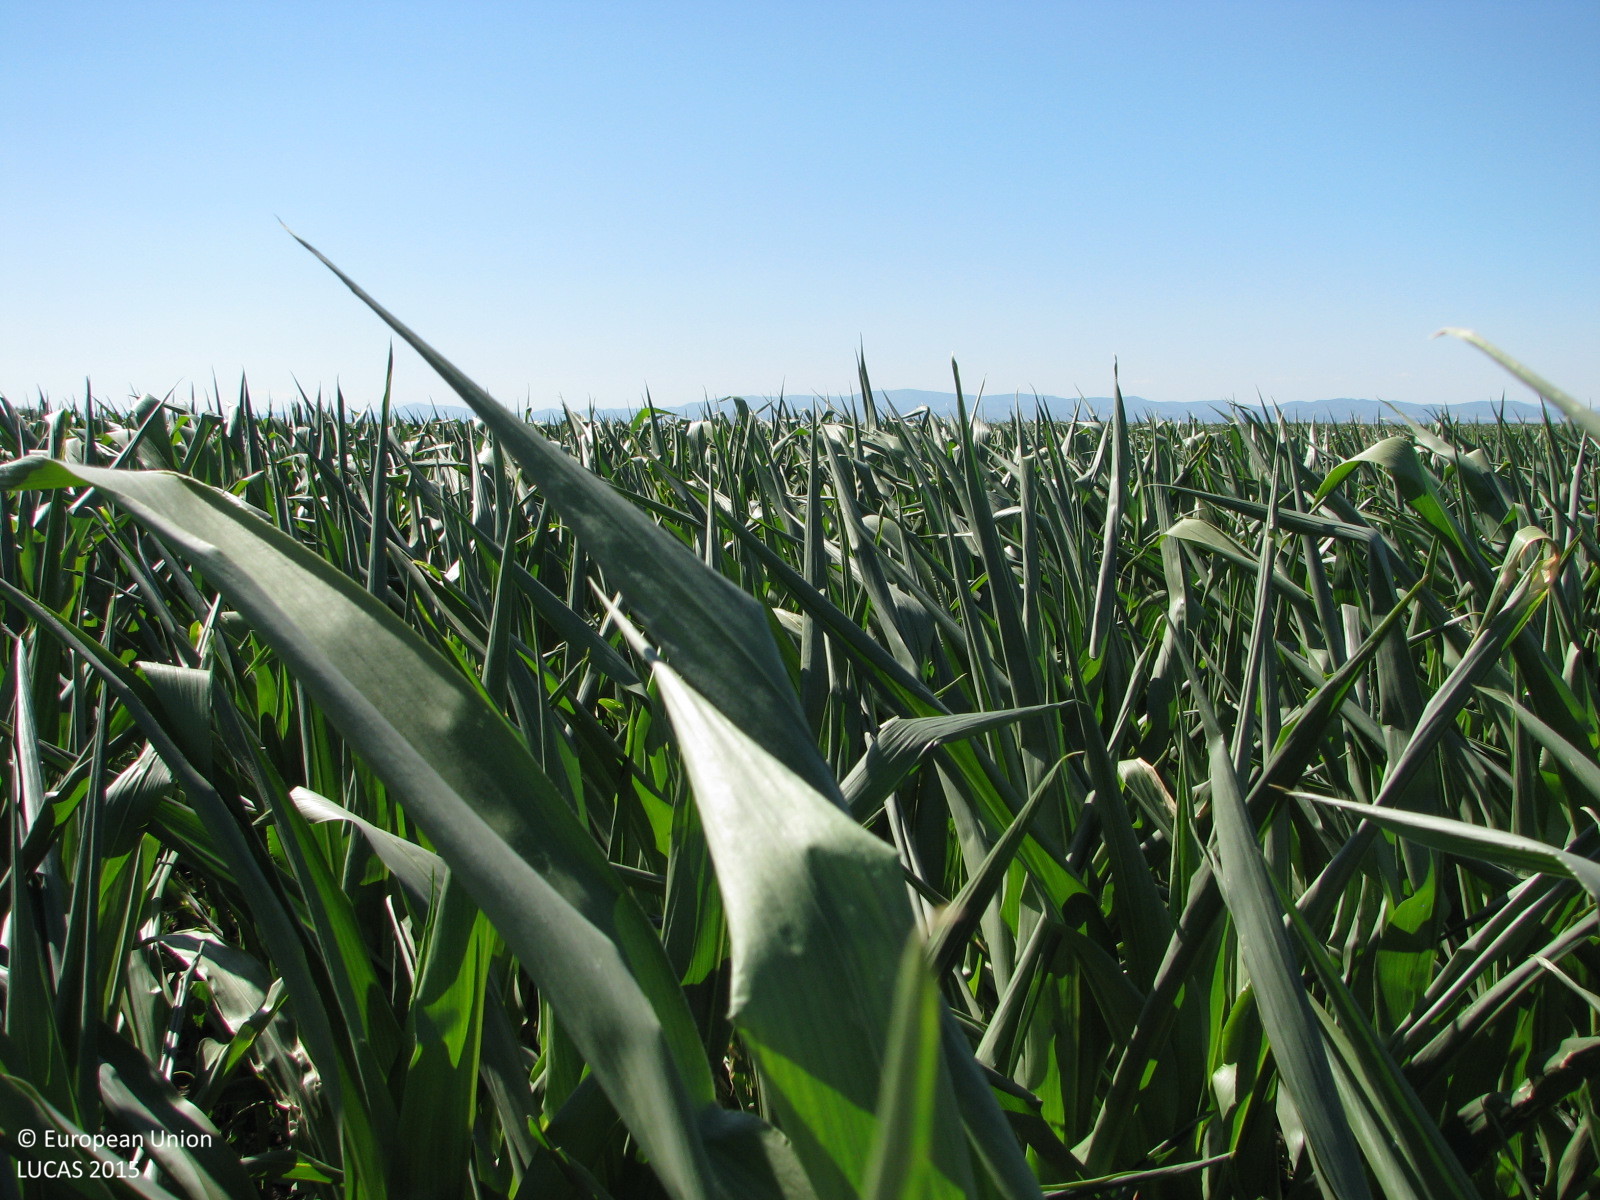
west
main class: Cropland
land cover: Maize
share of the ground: > 75 %
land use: Agriculture (excluding fallow land and kitchen gardens)
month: July
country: BG
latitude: 42.3650
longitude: 25.9978
